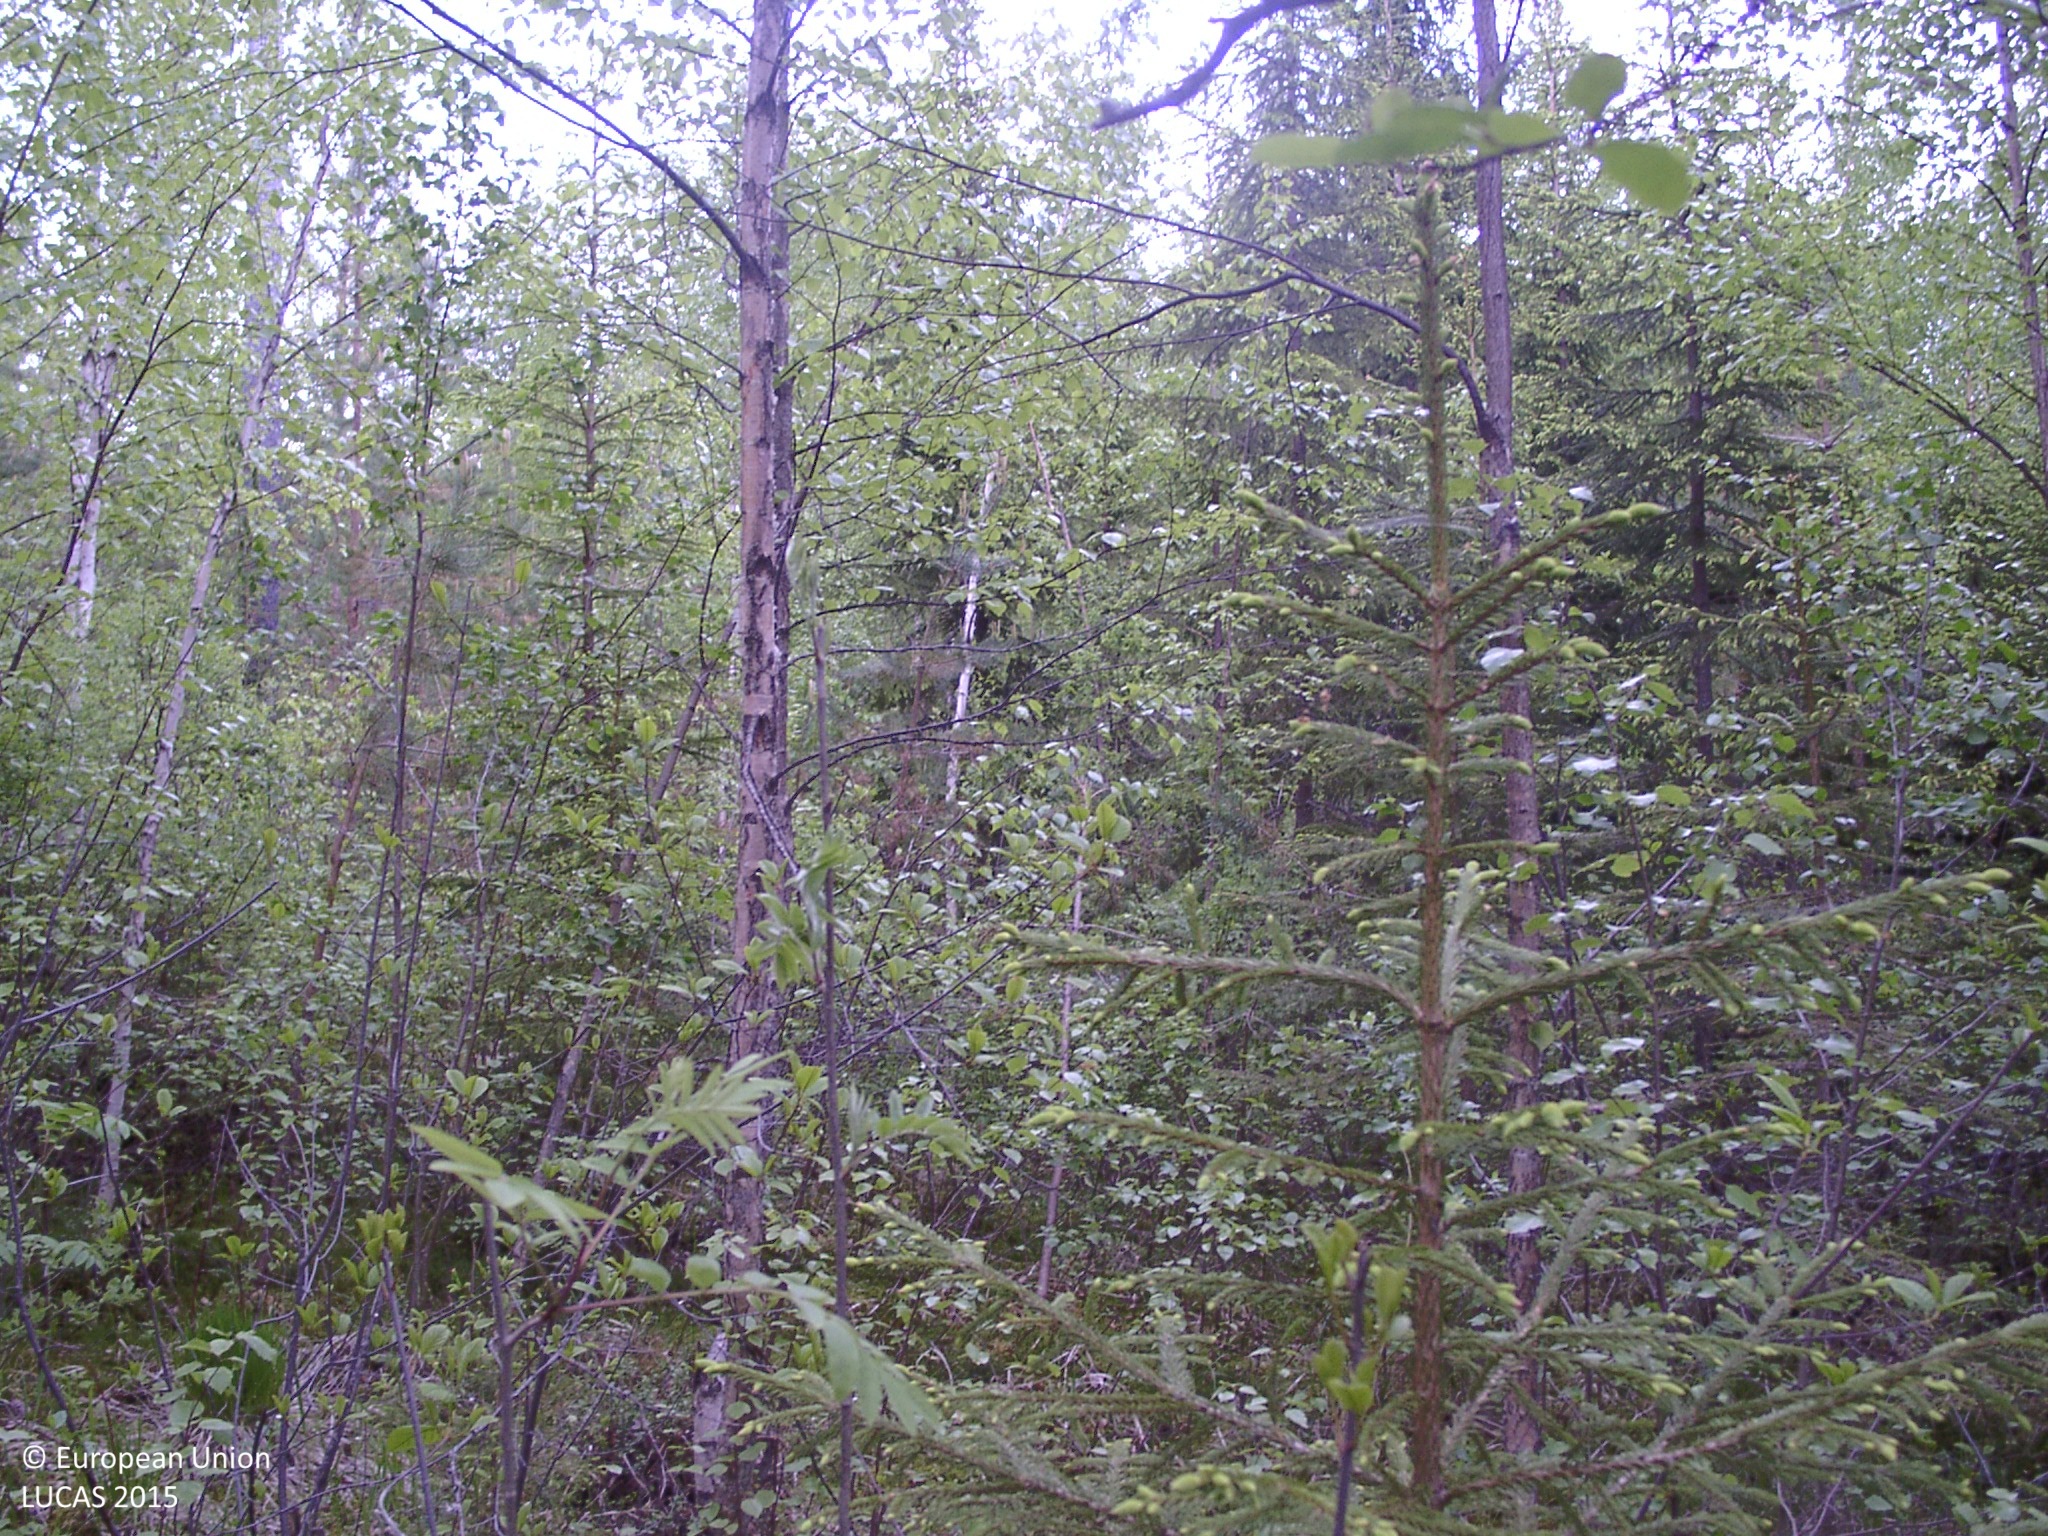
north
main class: Woodland
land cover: Spruce dominated mixed woodland
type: boreal forest
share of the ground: 50 - 75 %
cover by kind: broadleaved forest trees 40 %, shrubs 30 %, coniferous forest trees 20 %, herbaceous plants 5 %, lichens and mosses 5 %
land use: Semi-natural and natural areas not in use
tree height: > 5 m
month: June
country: FI
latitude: 62.4922
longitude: 25.7805
